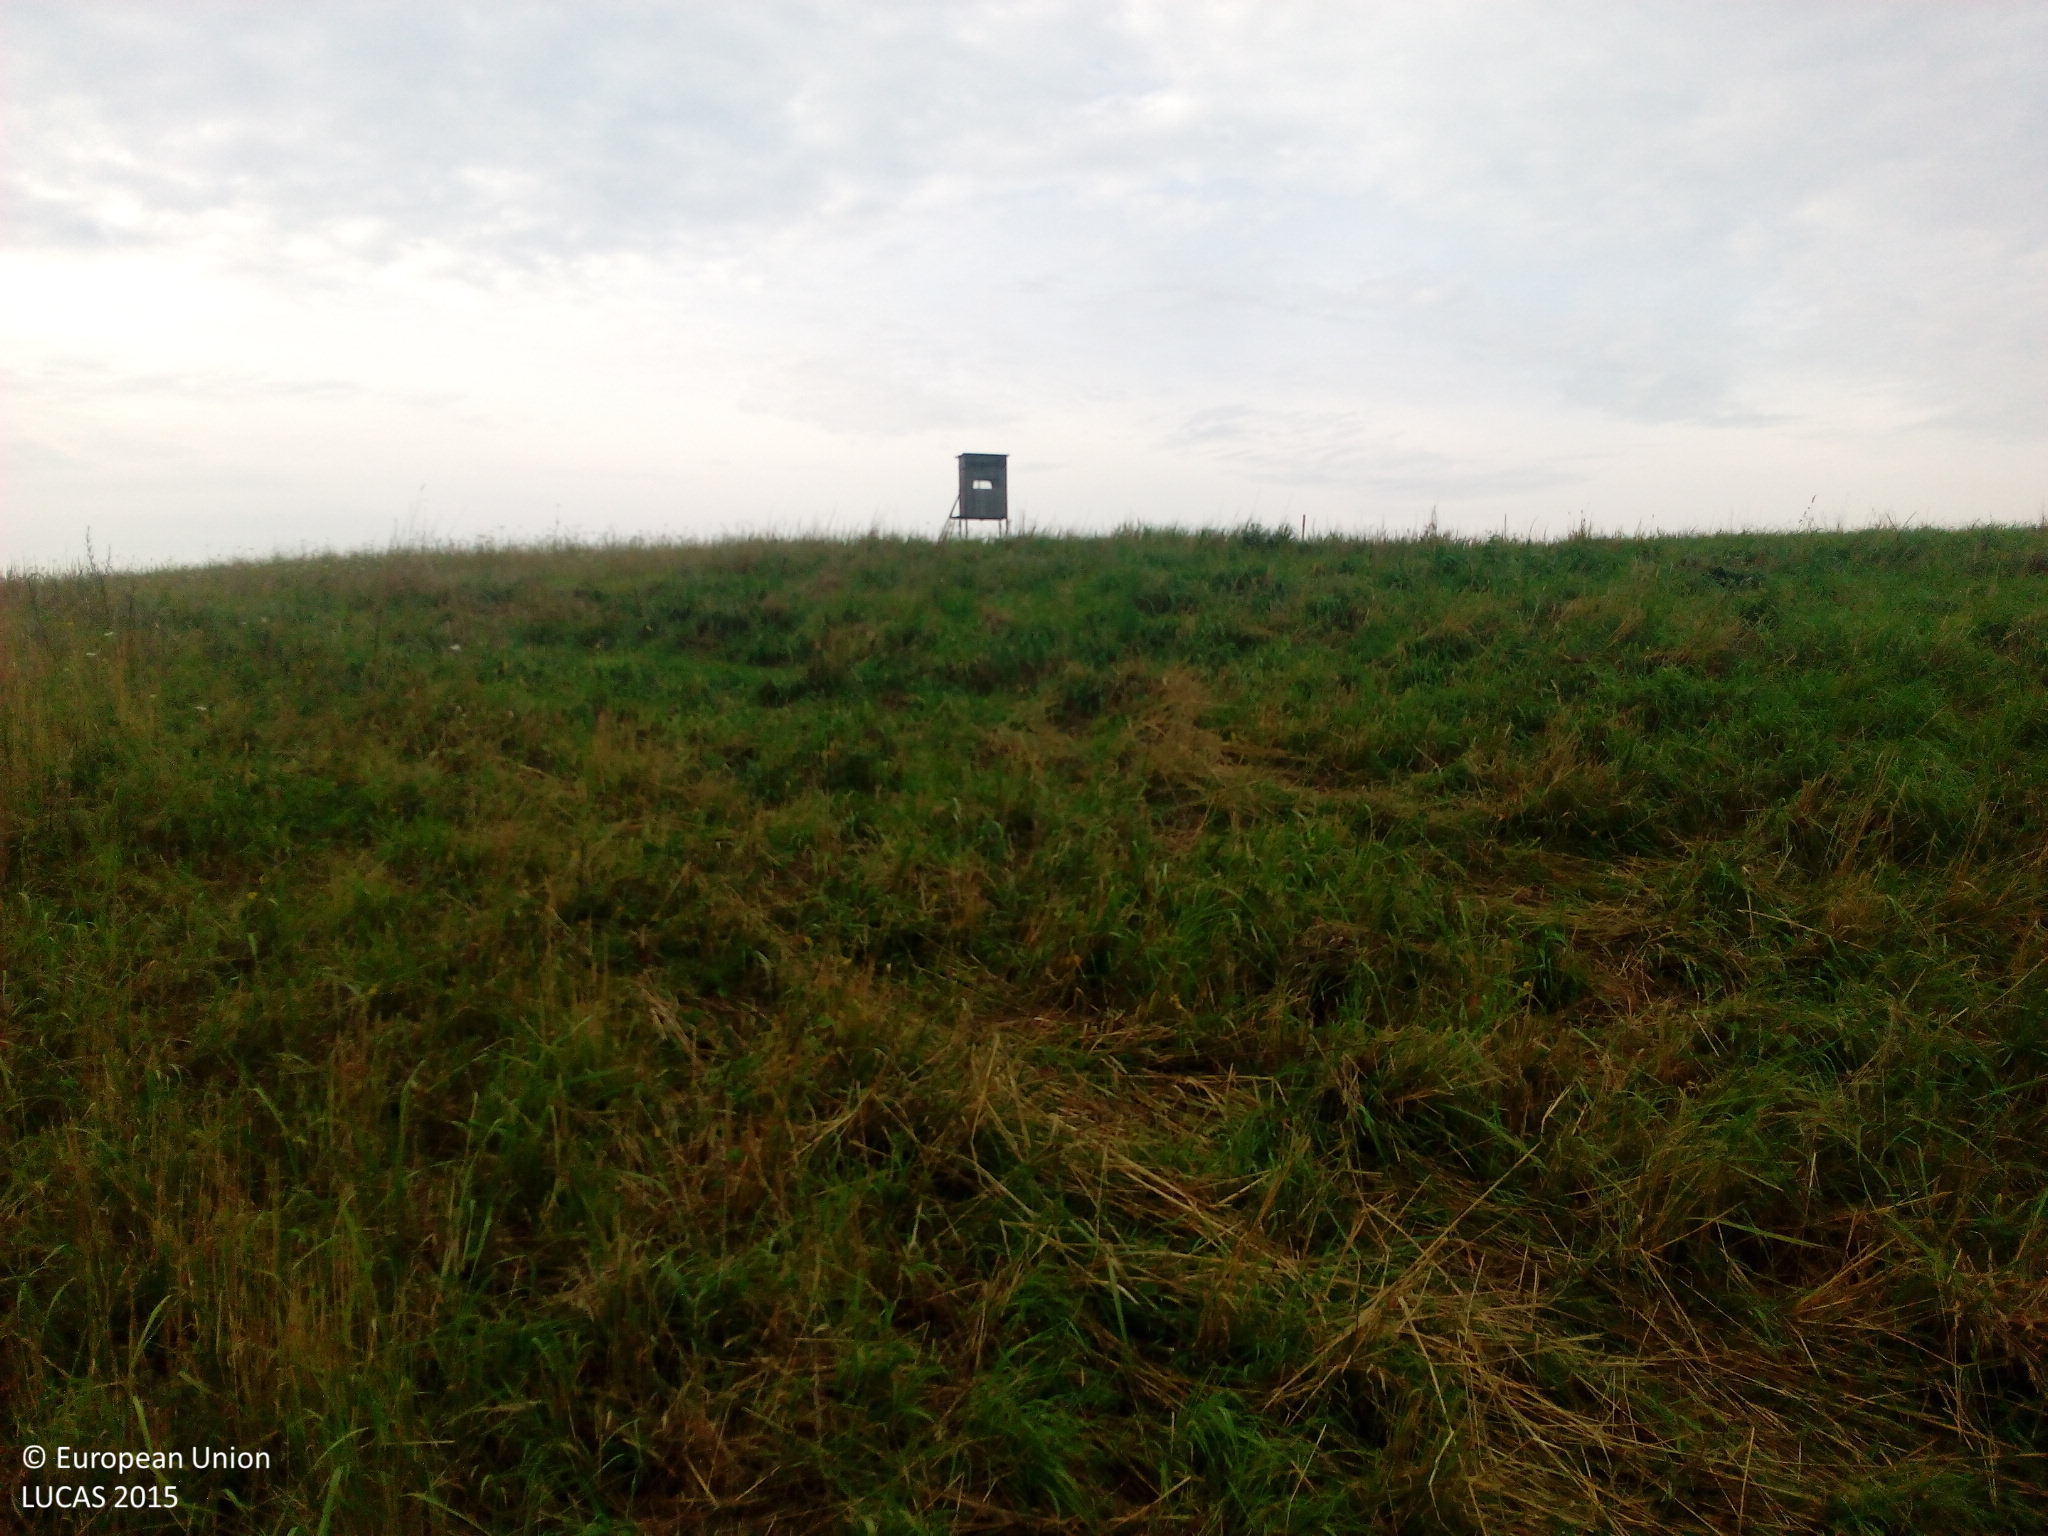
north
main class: Grassland
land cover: Grassland with sparse tree/shrub cover
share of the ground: > 75 %
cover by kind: herbaceous plants 95 %, broadleaved forest trees 5 %
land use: Agriculture (excluding fallow land and kitchen gardens)
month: August
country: DE
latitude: 53.6290
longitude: 13.2204
